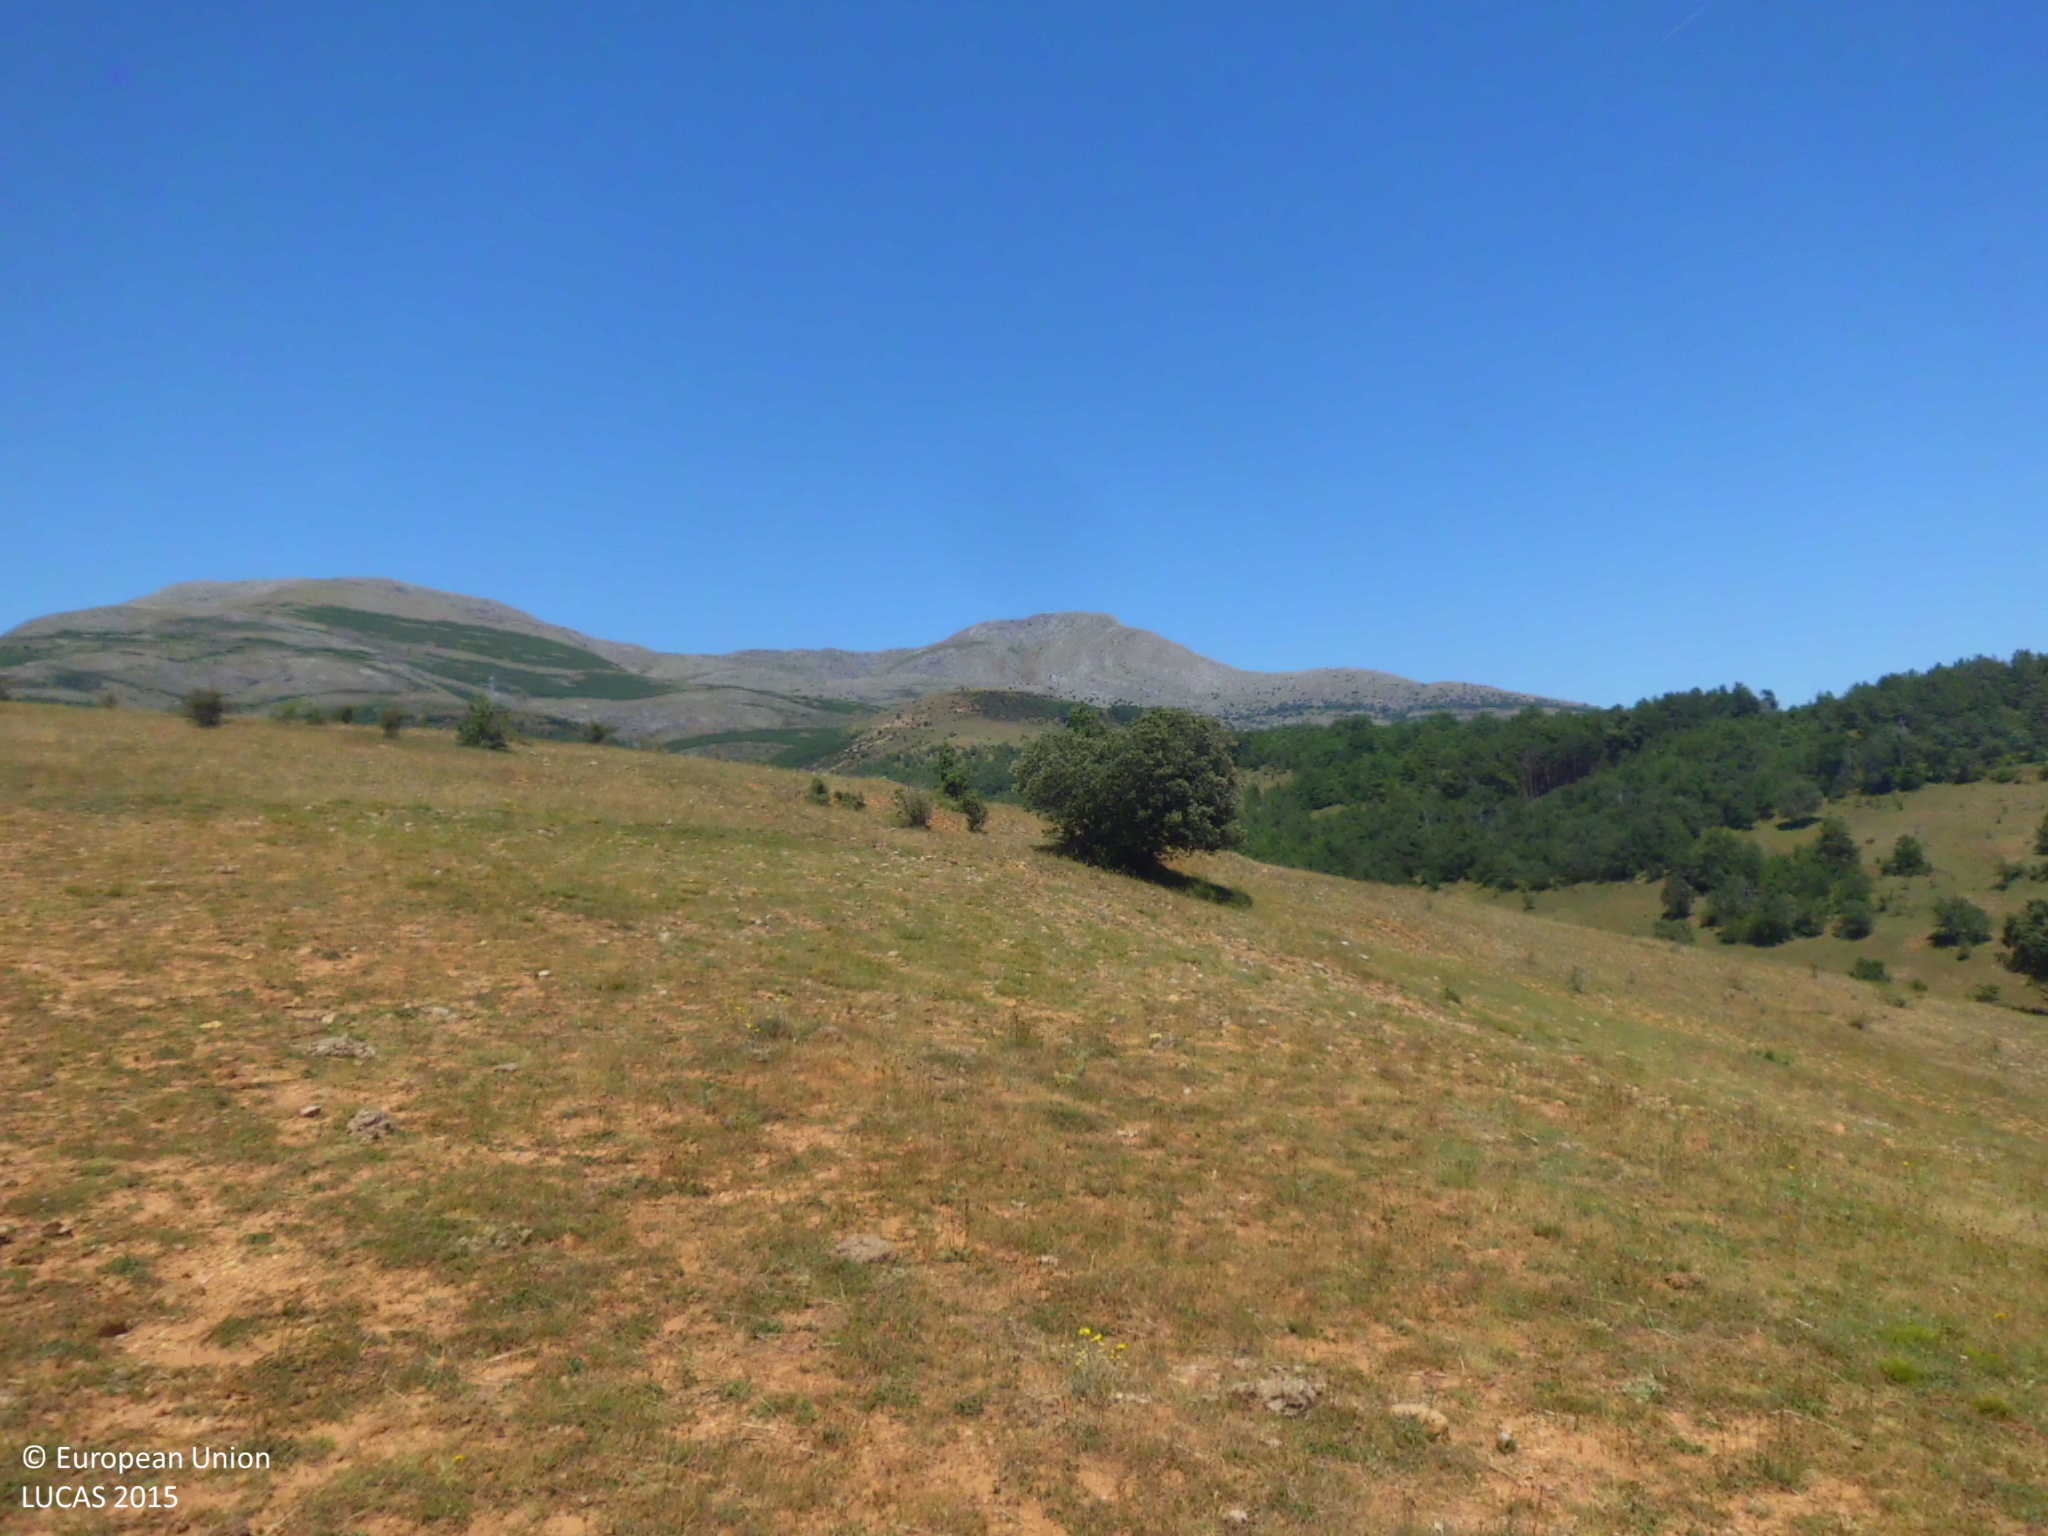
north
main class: Grassland
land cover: Spontaneously vegetated surfaces
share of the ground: 50 - 75 %
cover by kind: herbaceous plants 50 %, unconsolidated bare surface 50 %
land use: Fallow land
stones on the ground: > 50 %
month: June
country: ES
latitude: 42.7816
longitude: -5.0878
